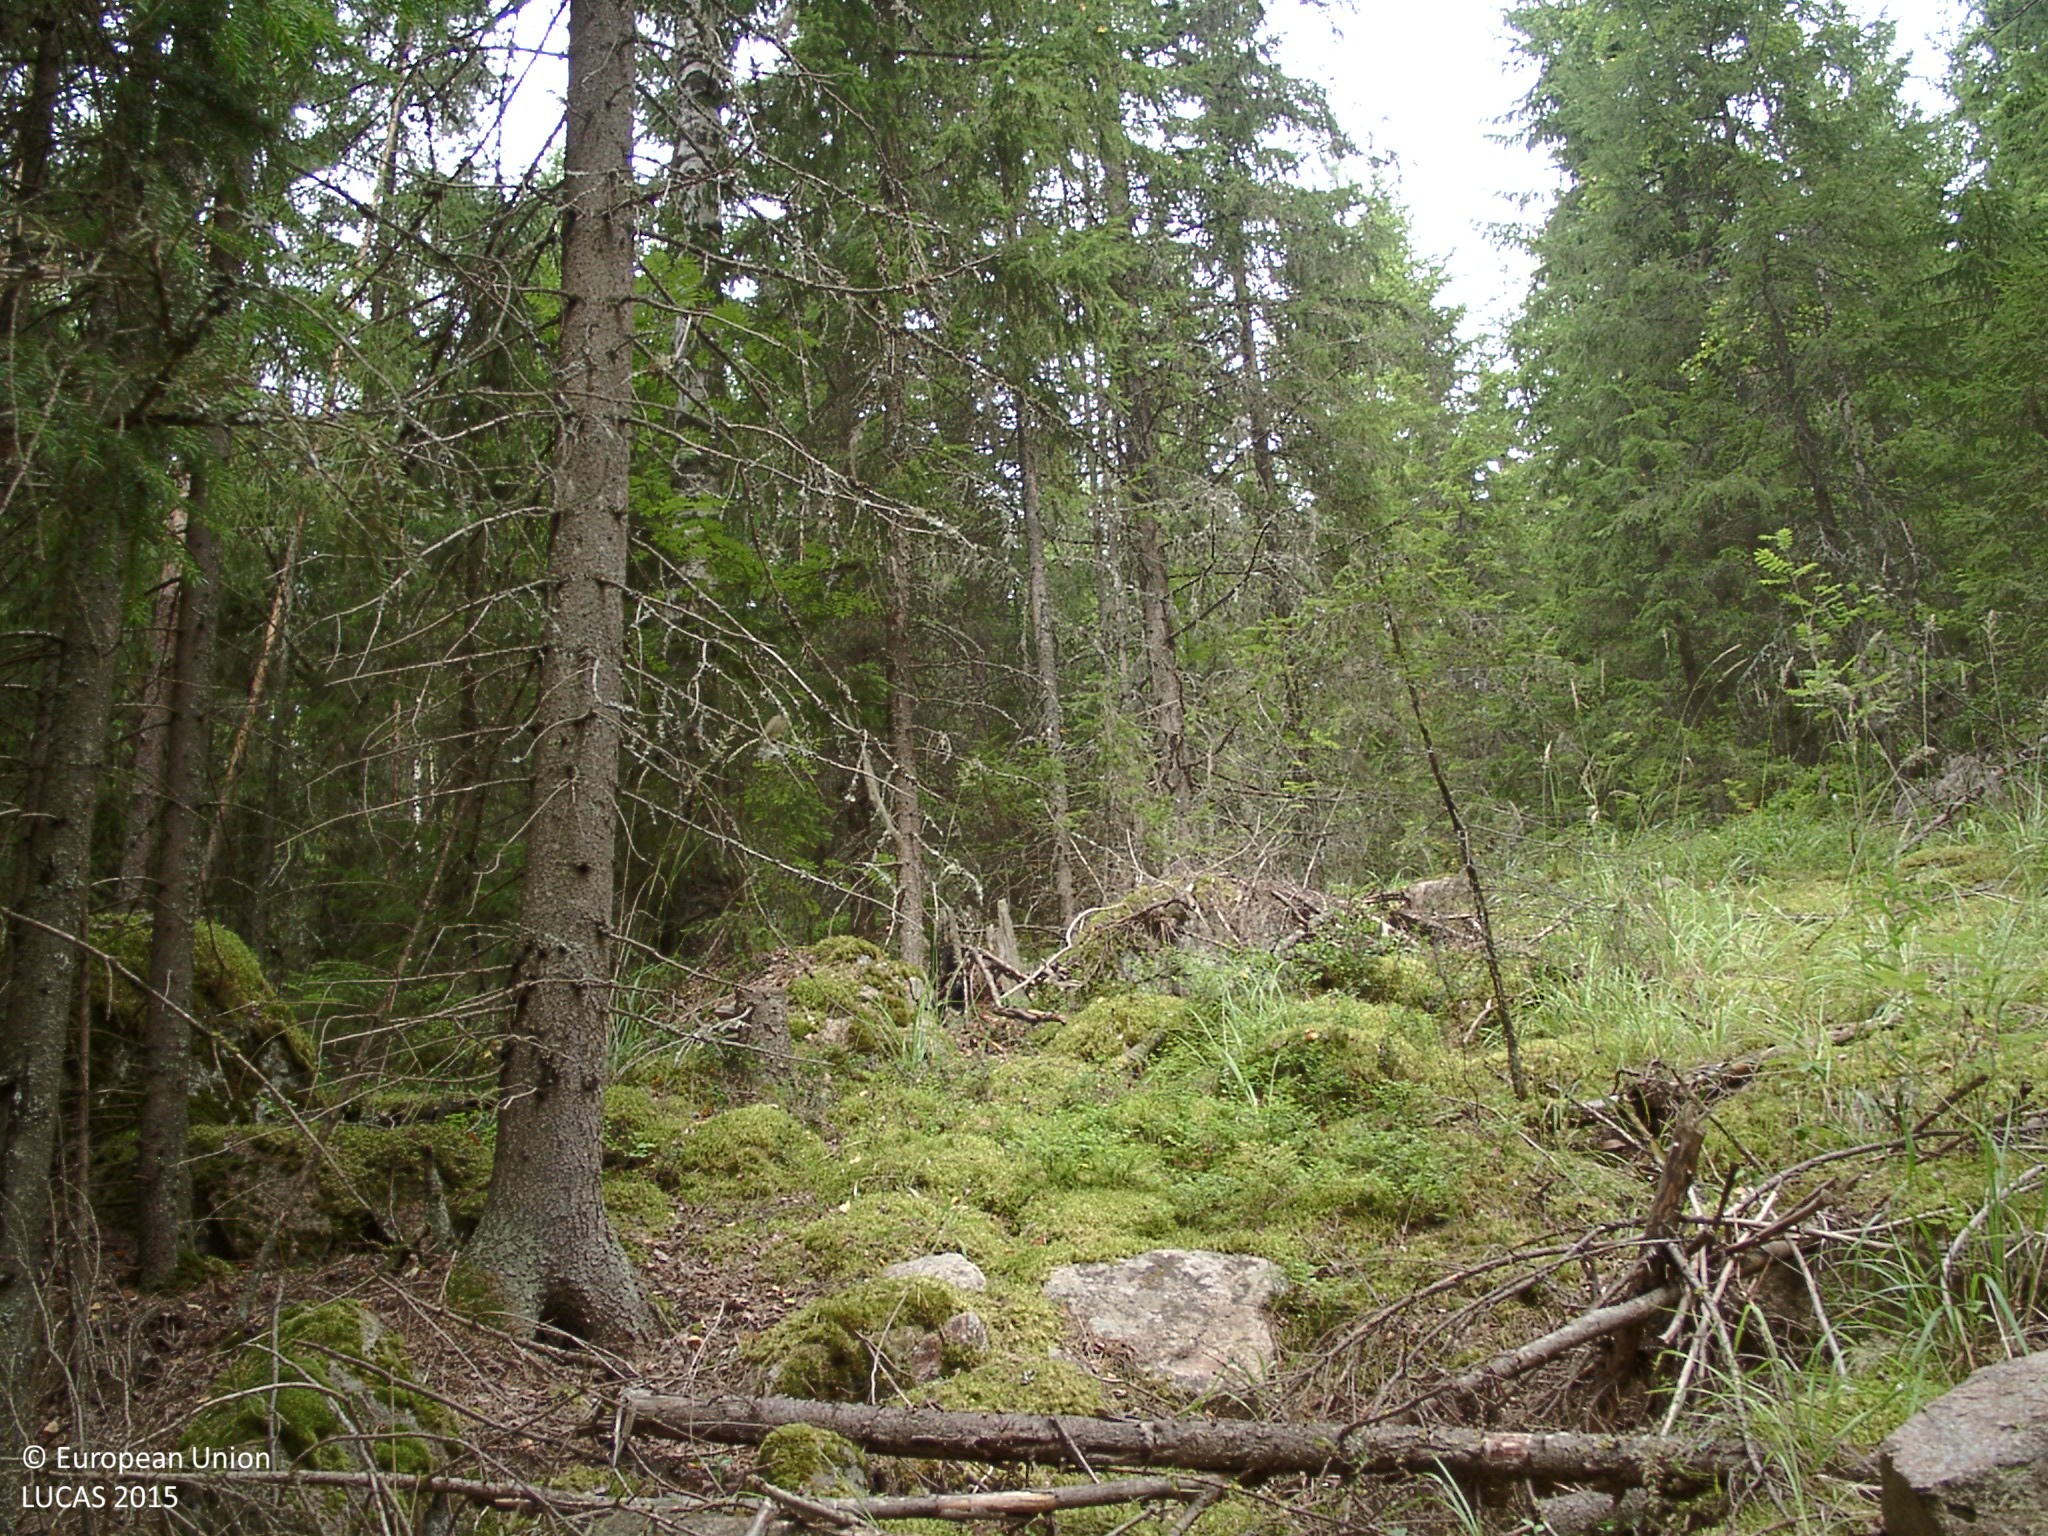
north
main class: Woodland
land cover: Other coniferous woodland
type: boreal forest
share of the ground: > 75 %
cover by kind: coniferous forest trees 60 %, broadleaved forest trees 15 %, lichens and mosses 10 %, unconsolidated bare surface 10 %, shrubs 5 %
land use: Forestry
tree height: > 5 m
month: August
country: FI
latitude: 61.8175
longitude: 25.3561
